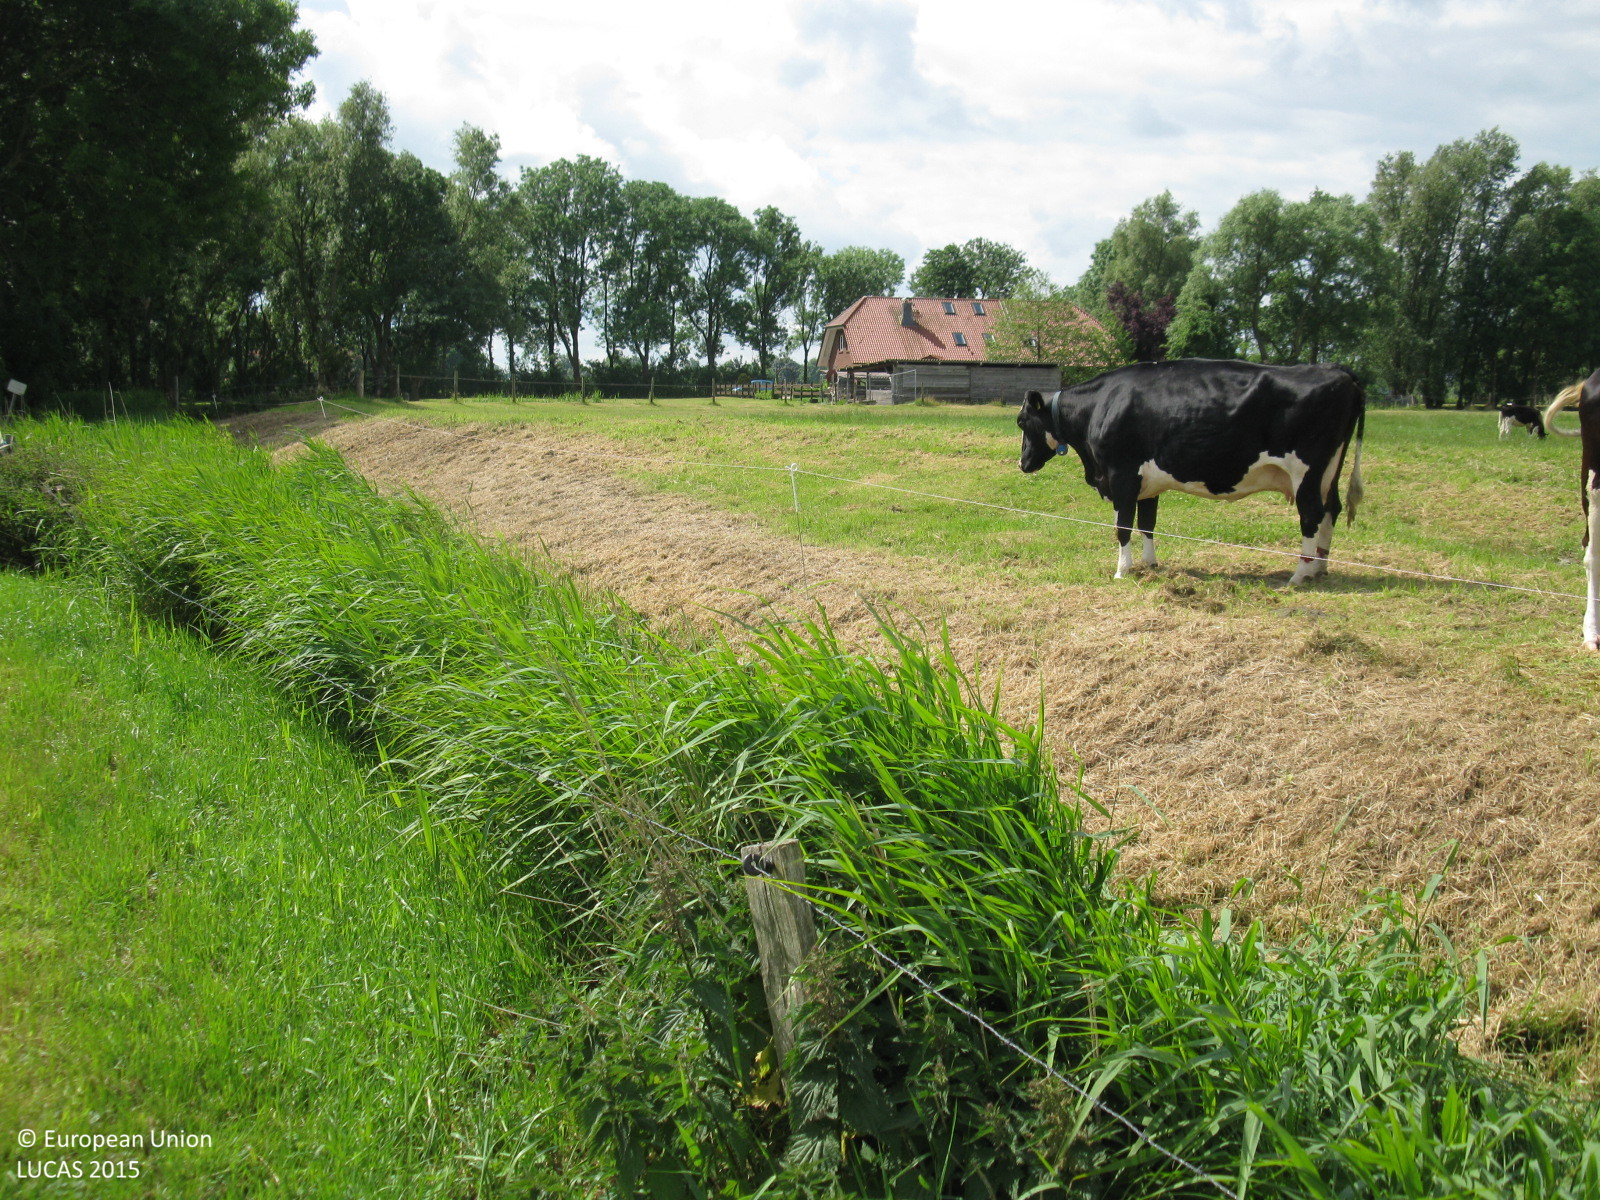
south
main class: Grassland
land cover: Grassland without tree/shrub cover
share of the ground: > 75 %
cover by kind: herbaceous plants 100 %
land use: Agriculture (excluding fallow land and kitchen gardens)
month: June
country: DE
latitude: 53.5107
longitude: 7.9650
